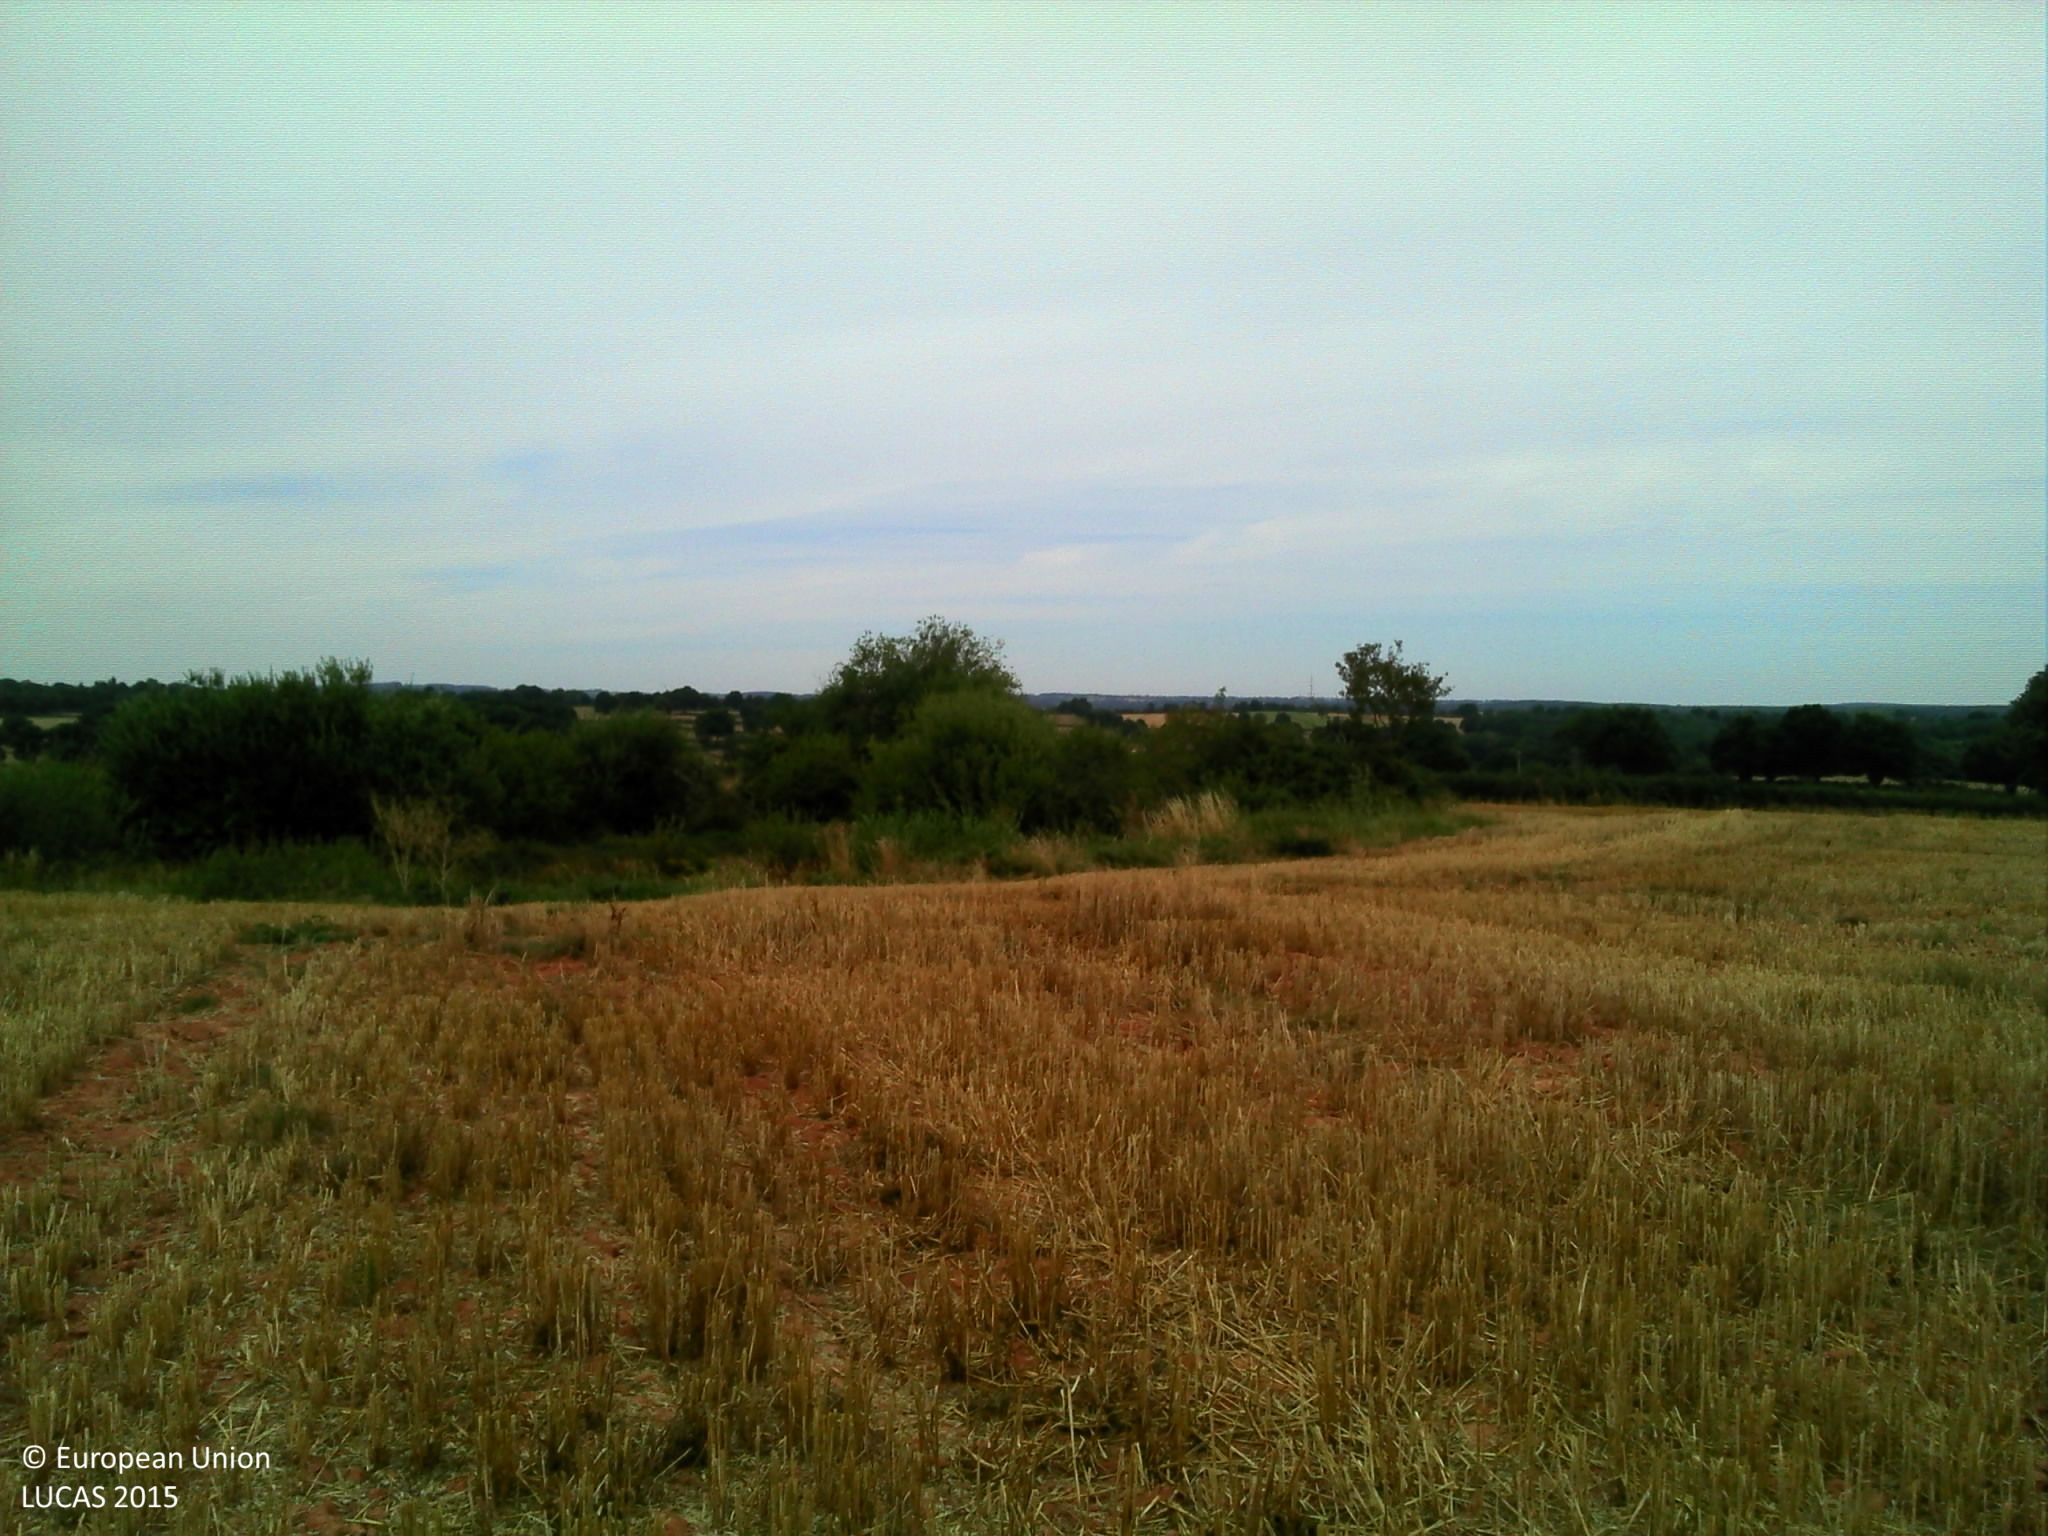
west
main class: Cropland
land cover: Common wheat
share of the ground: > 75 %
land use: Agriculture (excluding fallow land and kitchen gardens)
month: July
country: FR
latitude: 46.5730
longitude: 2.9903
